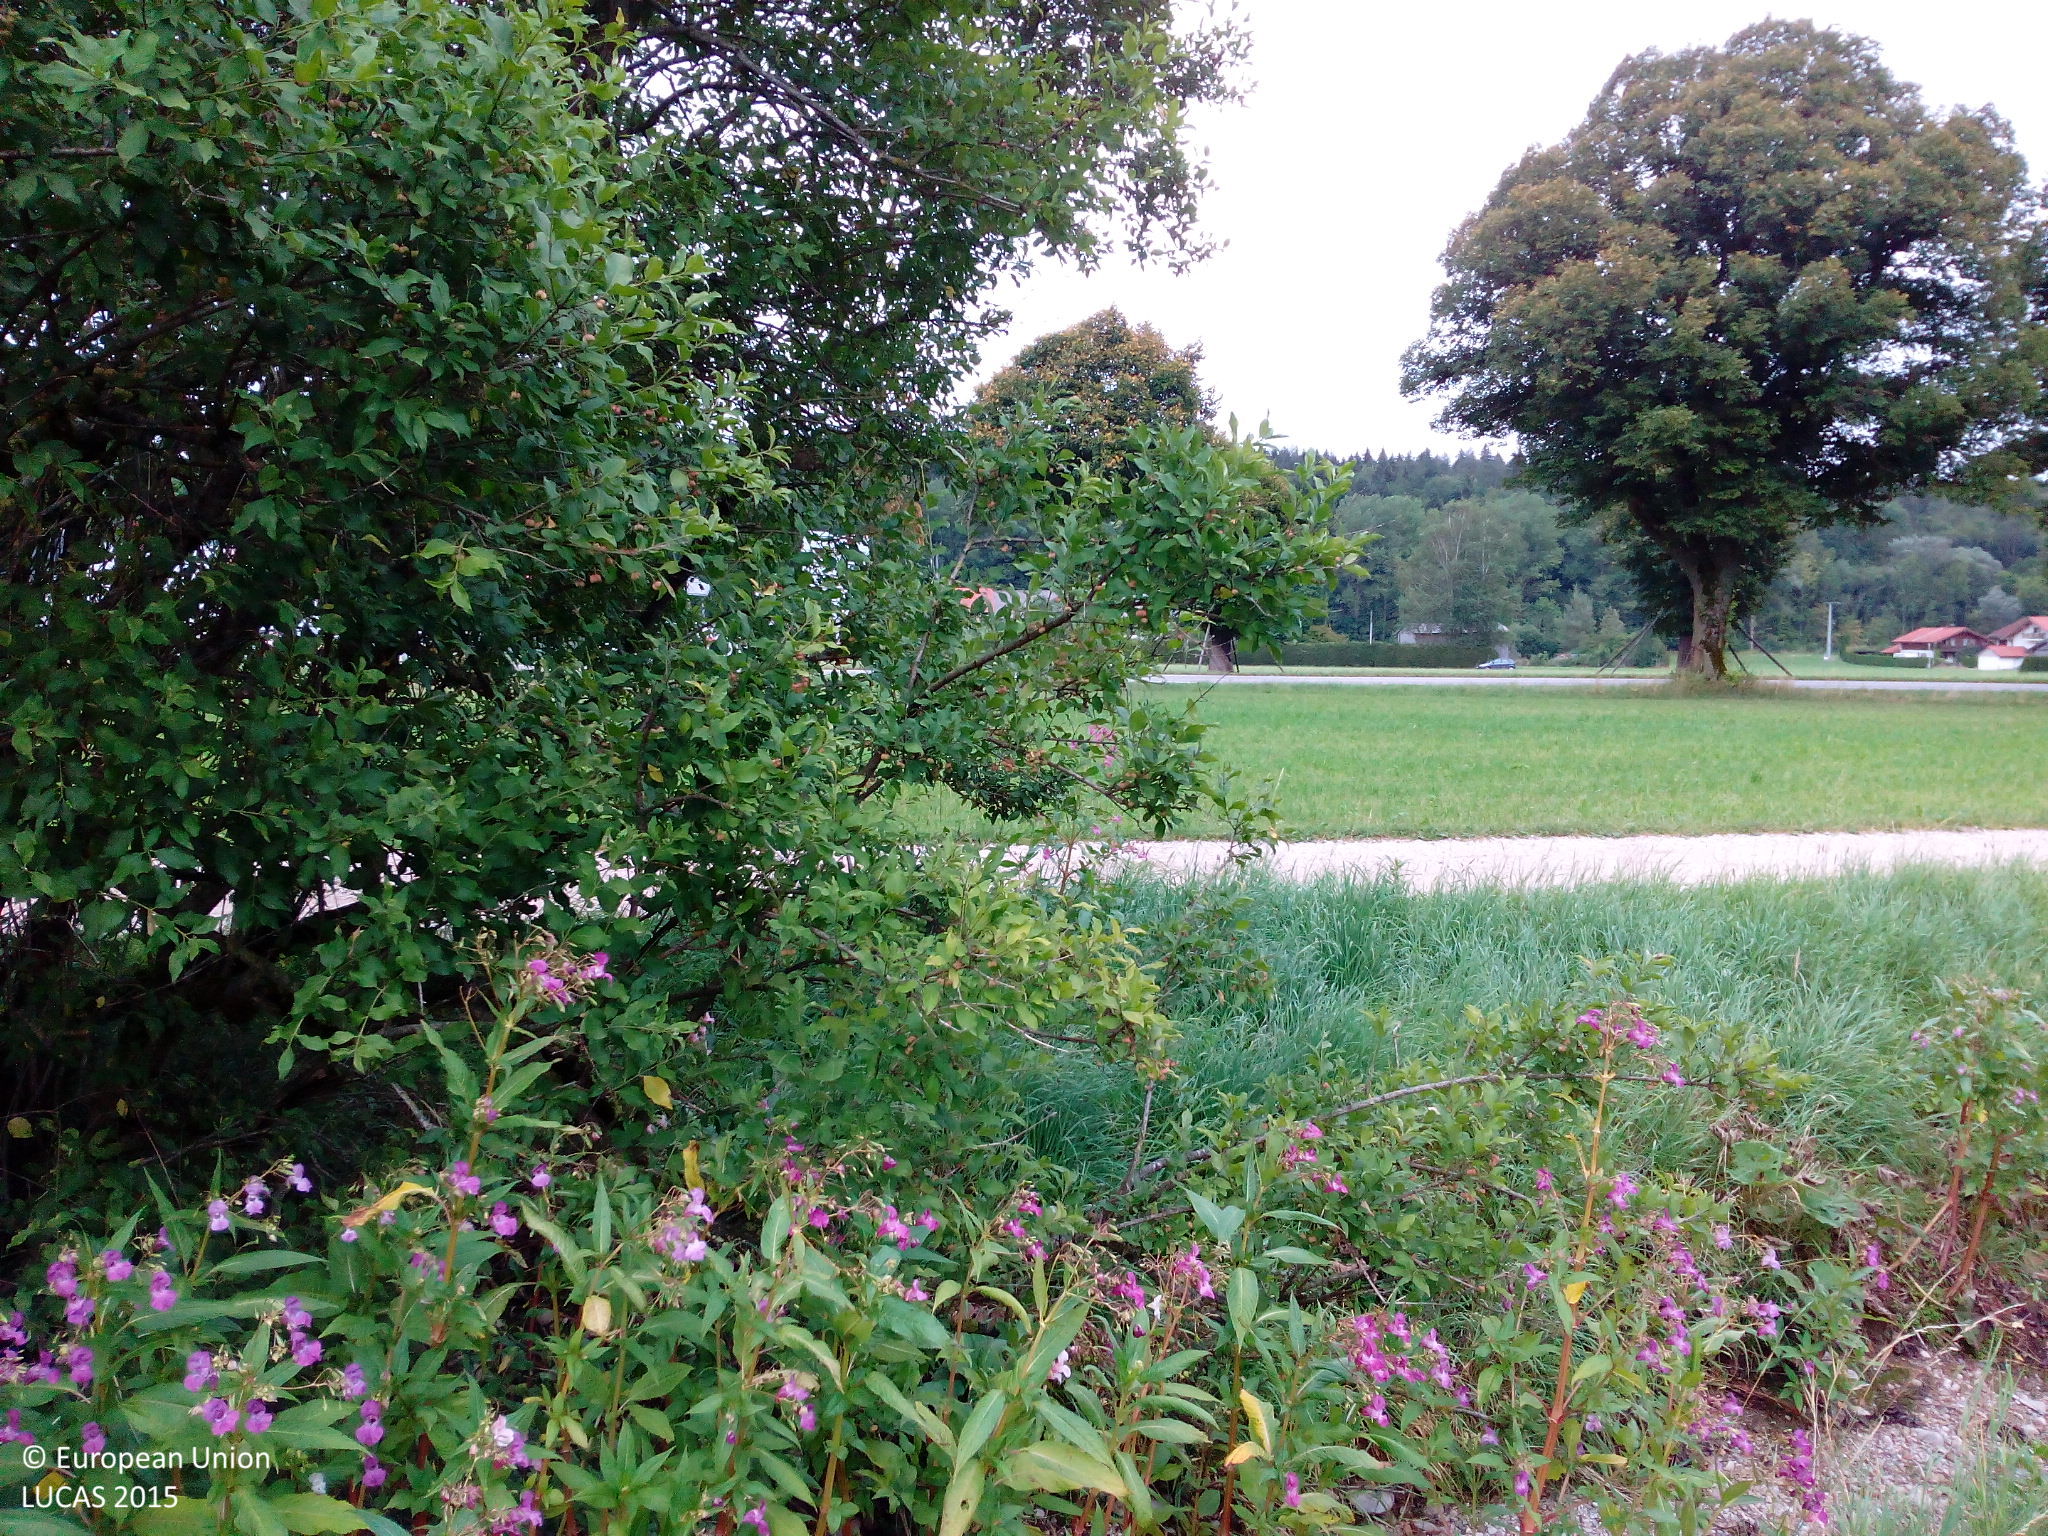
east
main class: Cropland
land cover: Temporary grasslands
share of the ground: 50 - 75 %
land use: Agriculture (excluding fallow land and kitchen gardens)
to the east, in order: Temporary grasslands; Broadleaved woodland; Ditches and canals; Broadleaved woodland; Tracks; Grassland without tree/shrub cover; Lines of trees; Paved roads, cycling and walking lanes; Lines of trees; Grassland without tree/shrub cover; Paved roads, cycling and walking lanes; Grassland without tree/shrub cover; Paved roads, cycling and walking lanes; Grassland without tree/shrub cover
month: August
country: DE
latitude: 47.7901
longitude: 12.8686
